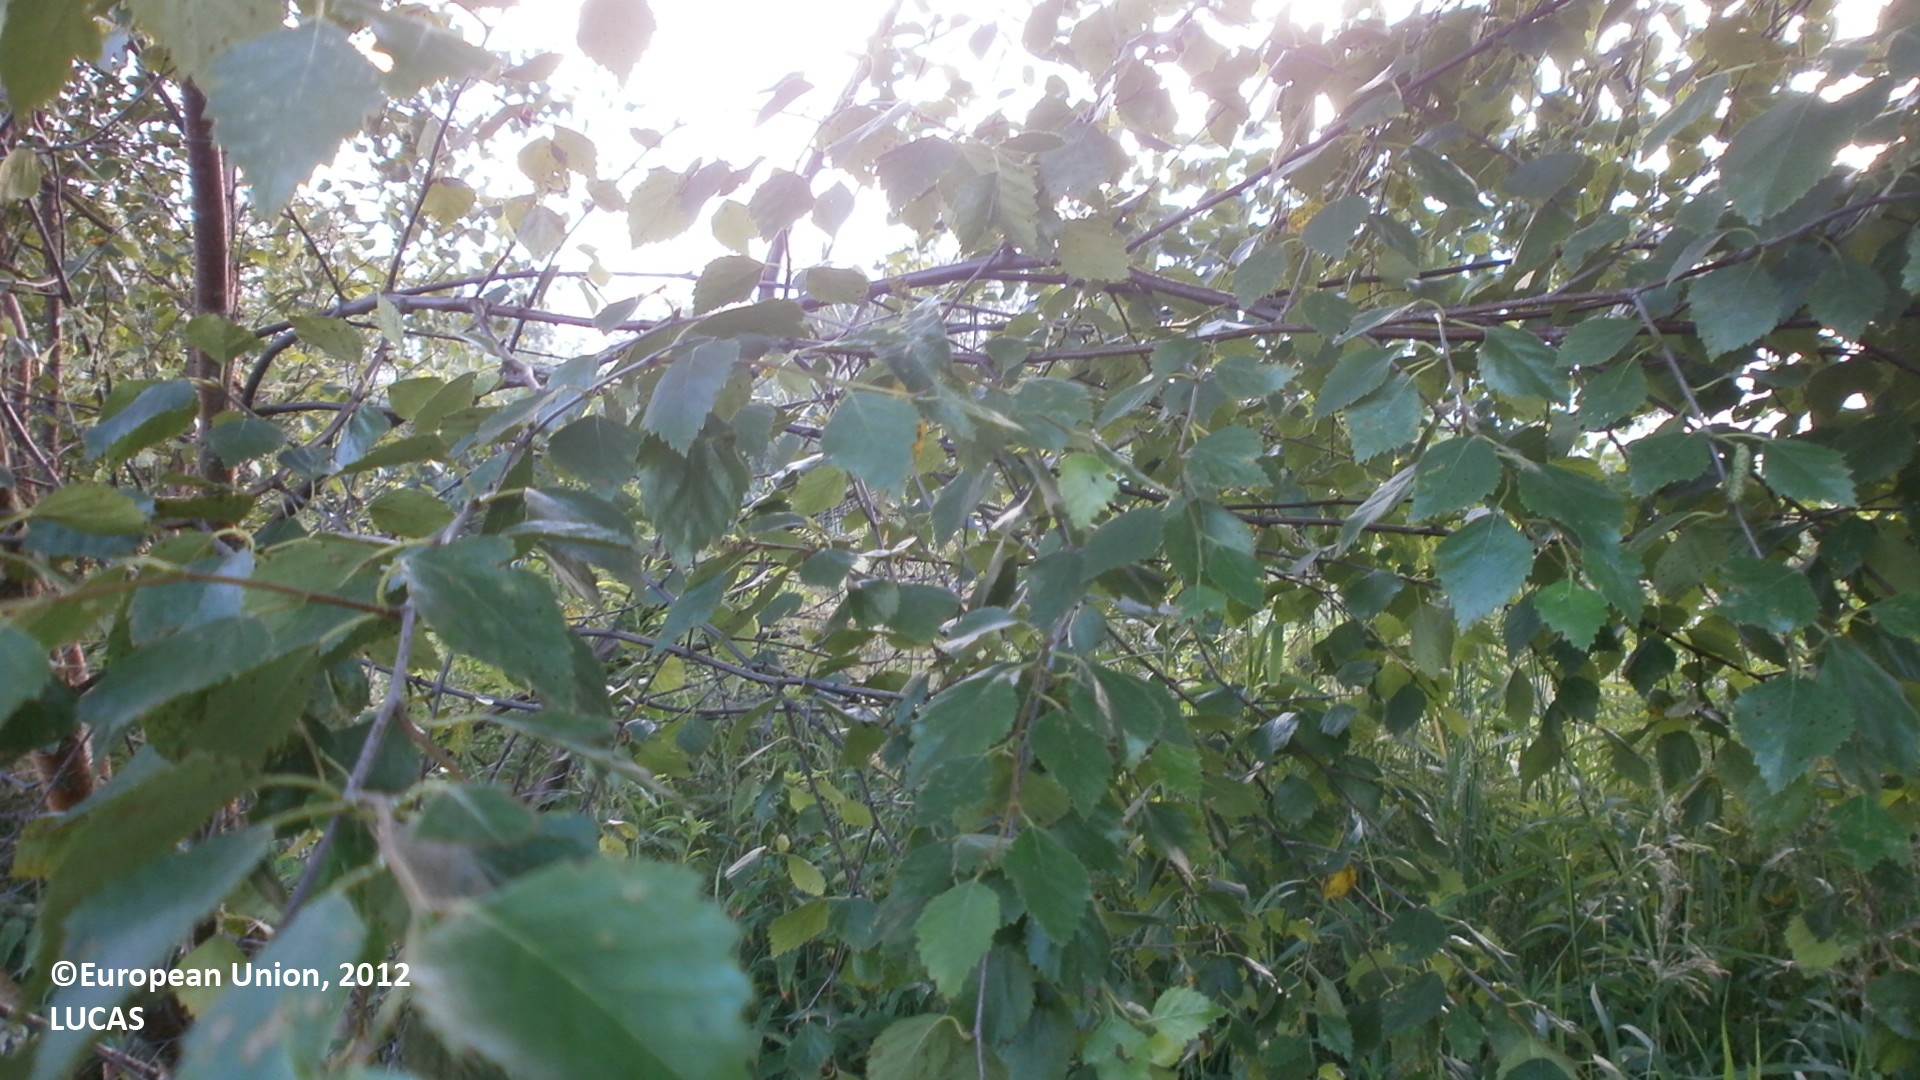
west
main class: Cropland
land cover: Potatoes
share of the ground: 50 - 75 %
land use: Agriculture (excluding fallow land and kitchen gardens)
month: July
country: FI
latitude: 64.1256
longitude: 24.1769
